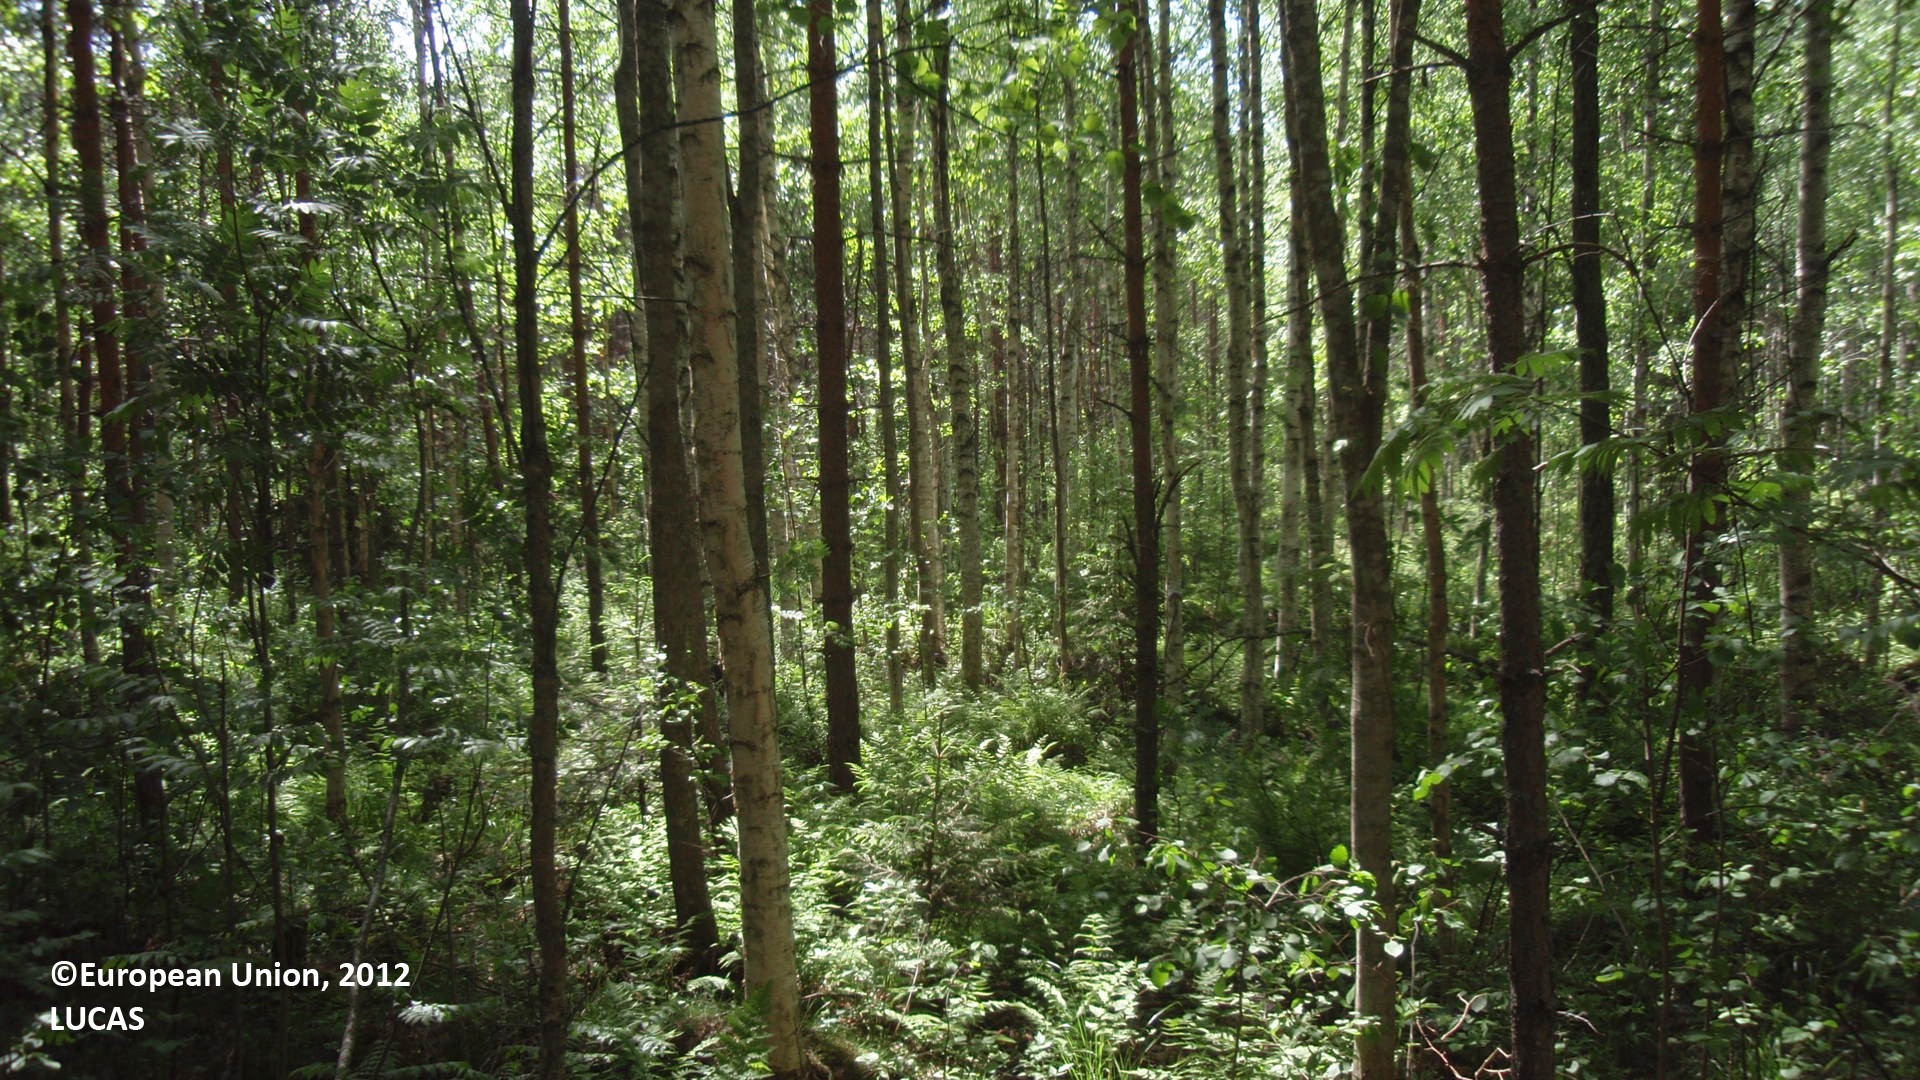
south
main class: Woodland
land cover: Pine dominated mixed woodland
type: boreal forest
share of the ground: > 75 %
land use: Forestry
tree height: > 5 m
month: June
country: FI
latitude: 61.6277
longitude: 28.4112
